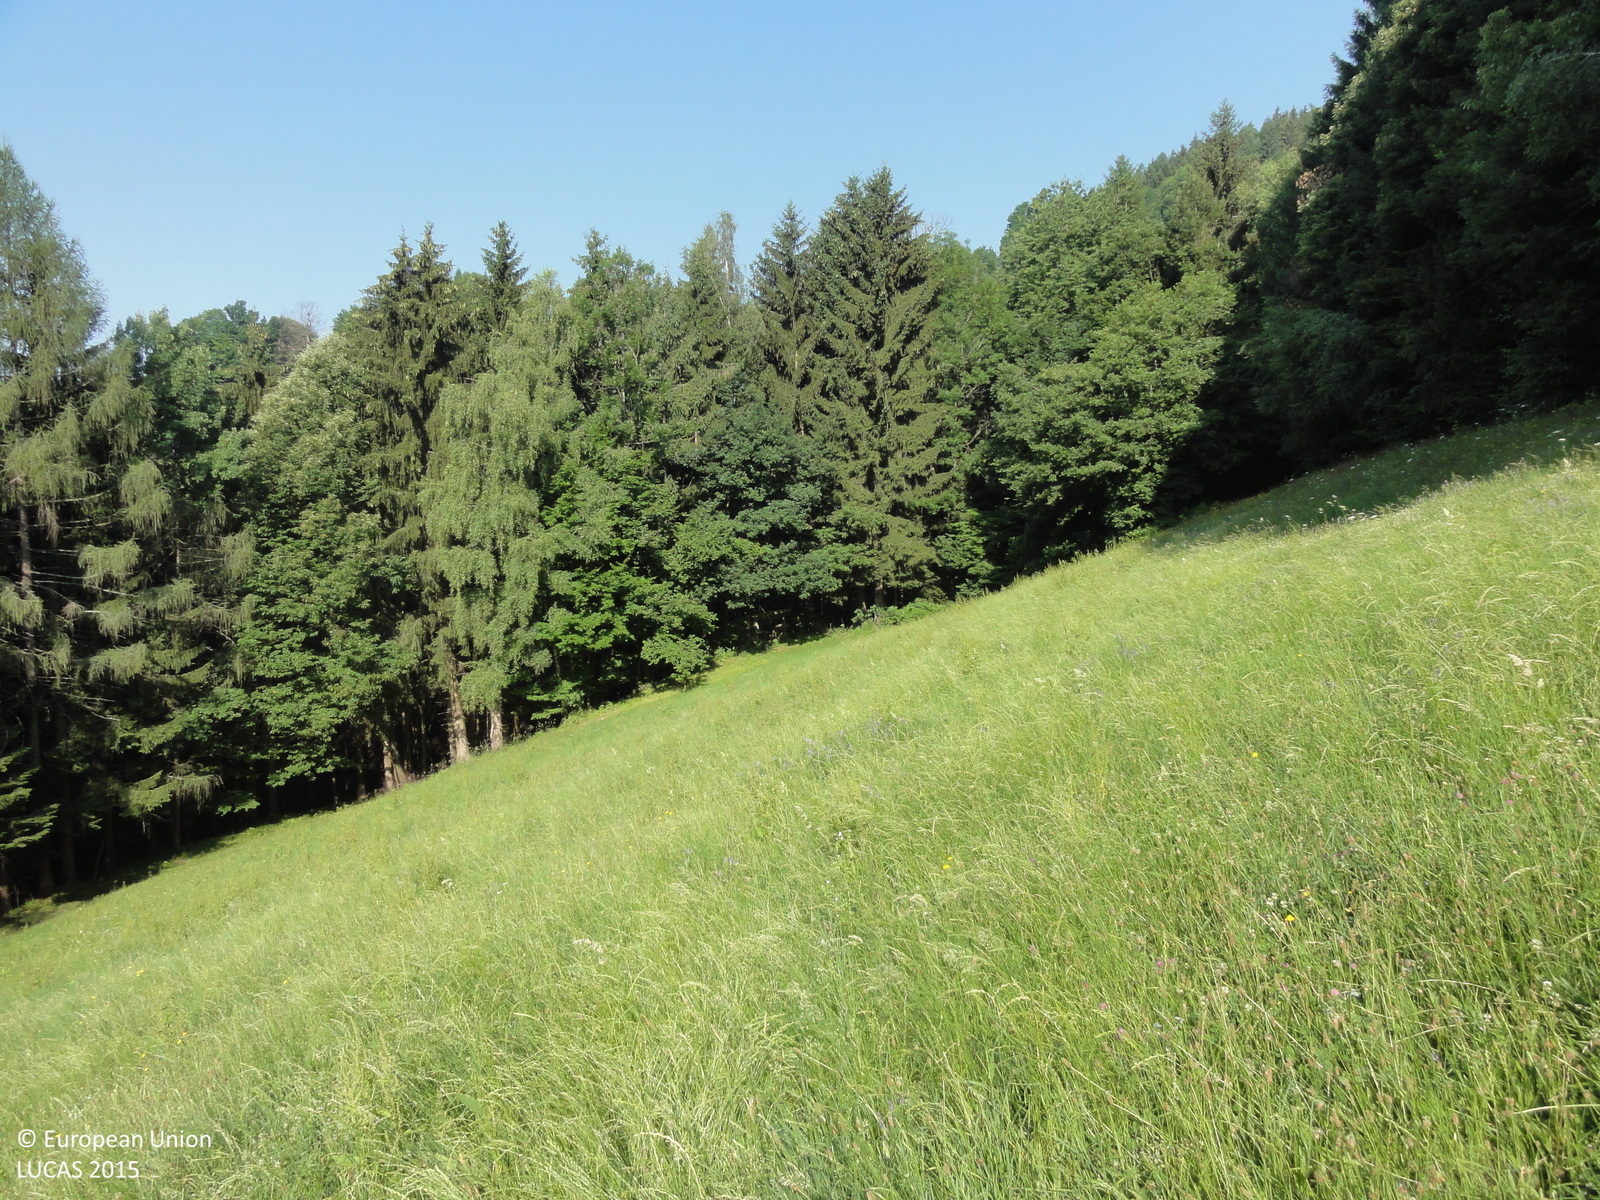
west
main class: Grassland
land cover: Grassland without tree/shrub cover
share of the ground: > 75 %
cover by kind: herbaceous plants 100 %
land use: Agriculture (excluding fallow land and kitchen gardens)
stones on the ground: < 10 %
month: July
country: SI
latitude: 46.4774
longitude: 15.5604
